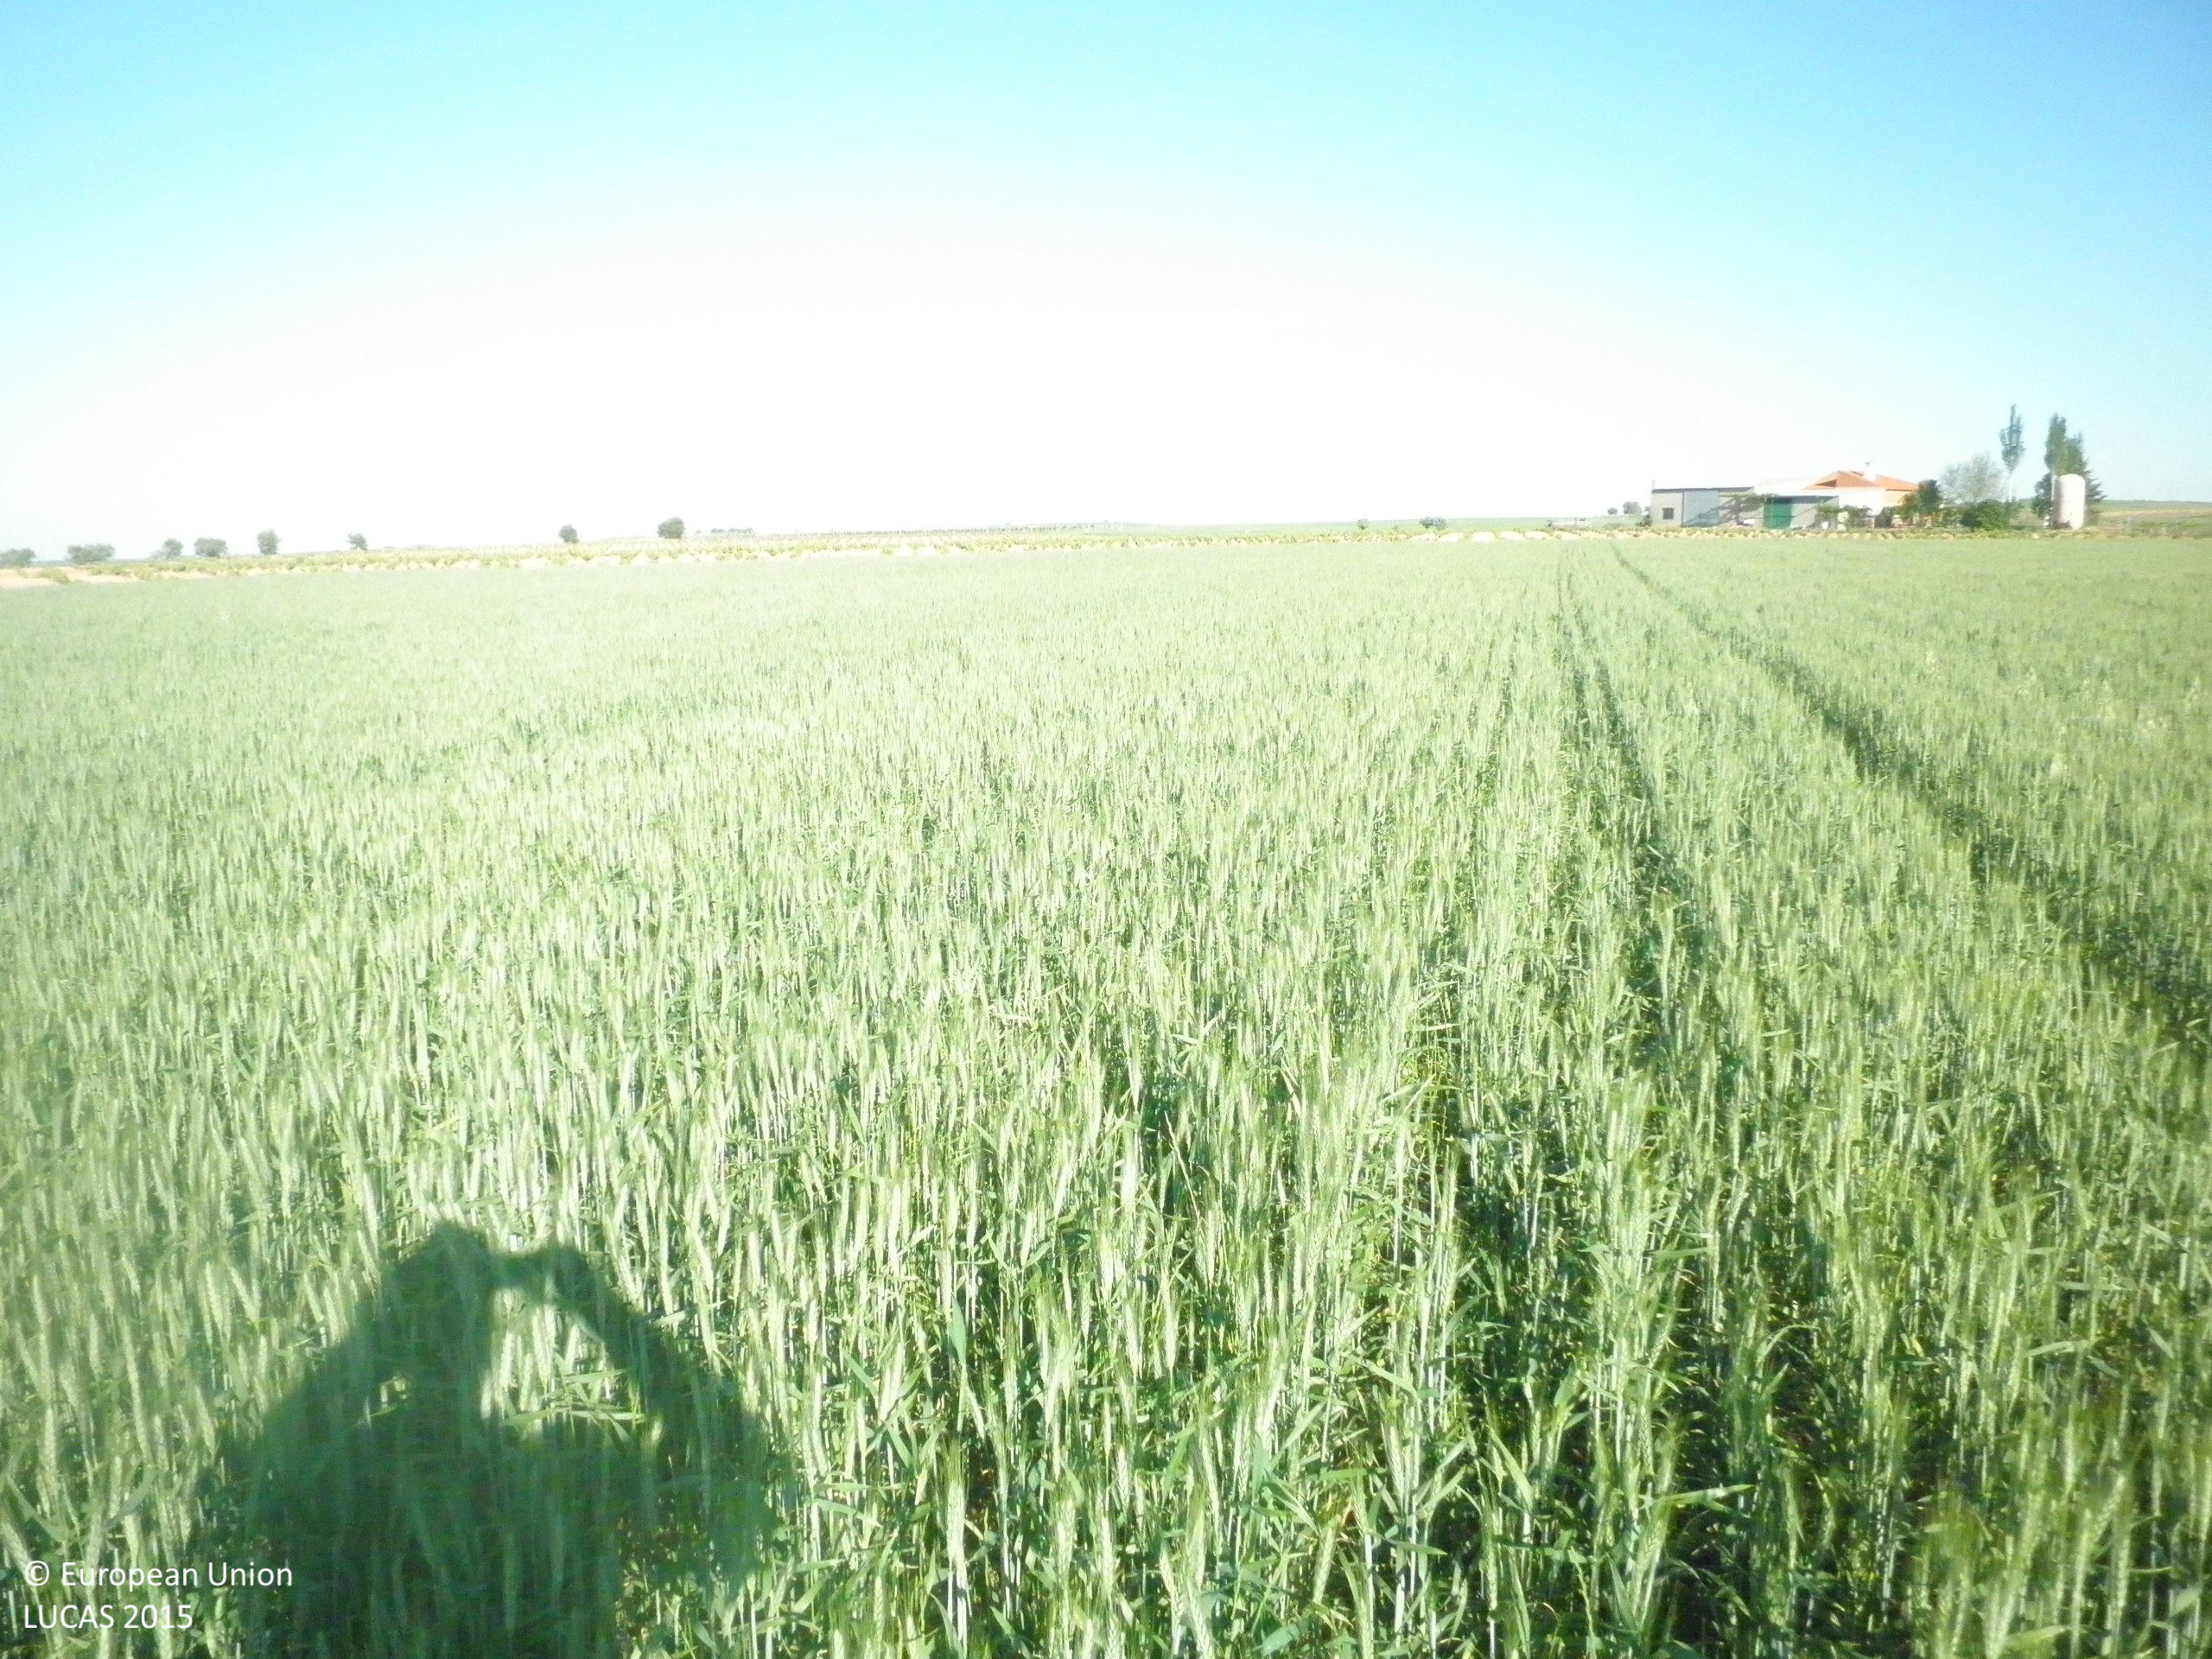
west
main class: Cropland
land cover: Durum wheat
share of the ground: > 75 %
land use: Agriculture (excluding fallow land and kitchen gardens)
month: May
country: ES
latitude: 39.4576
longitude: -2.6929
